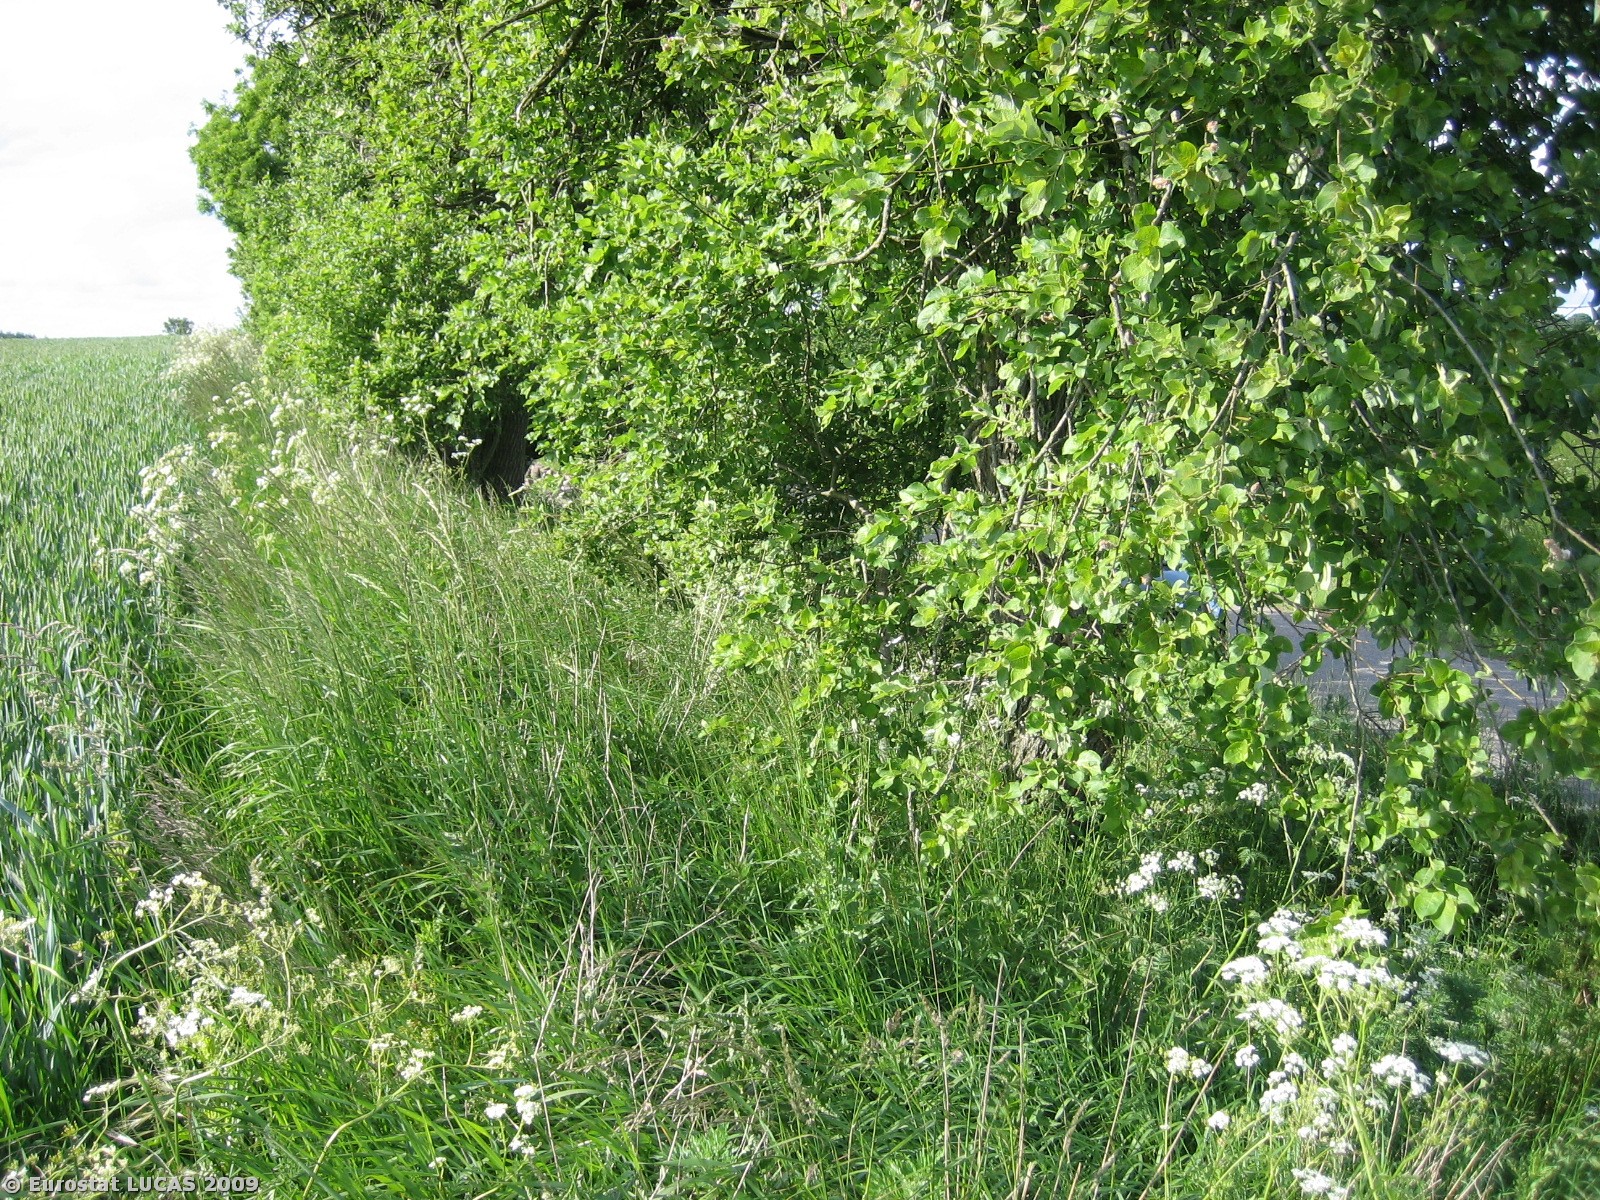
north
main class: Cropland
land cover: Common wheat
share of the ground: > 75 %
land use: Agriculture (excluding fallow land and kitchen gardens)
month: June
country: DK
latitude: 56.1515
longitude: 9.7267
